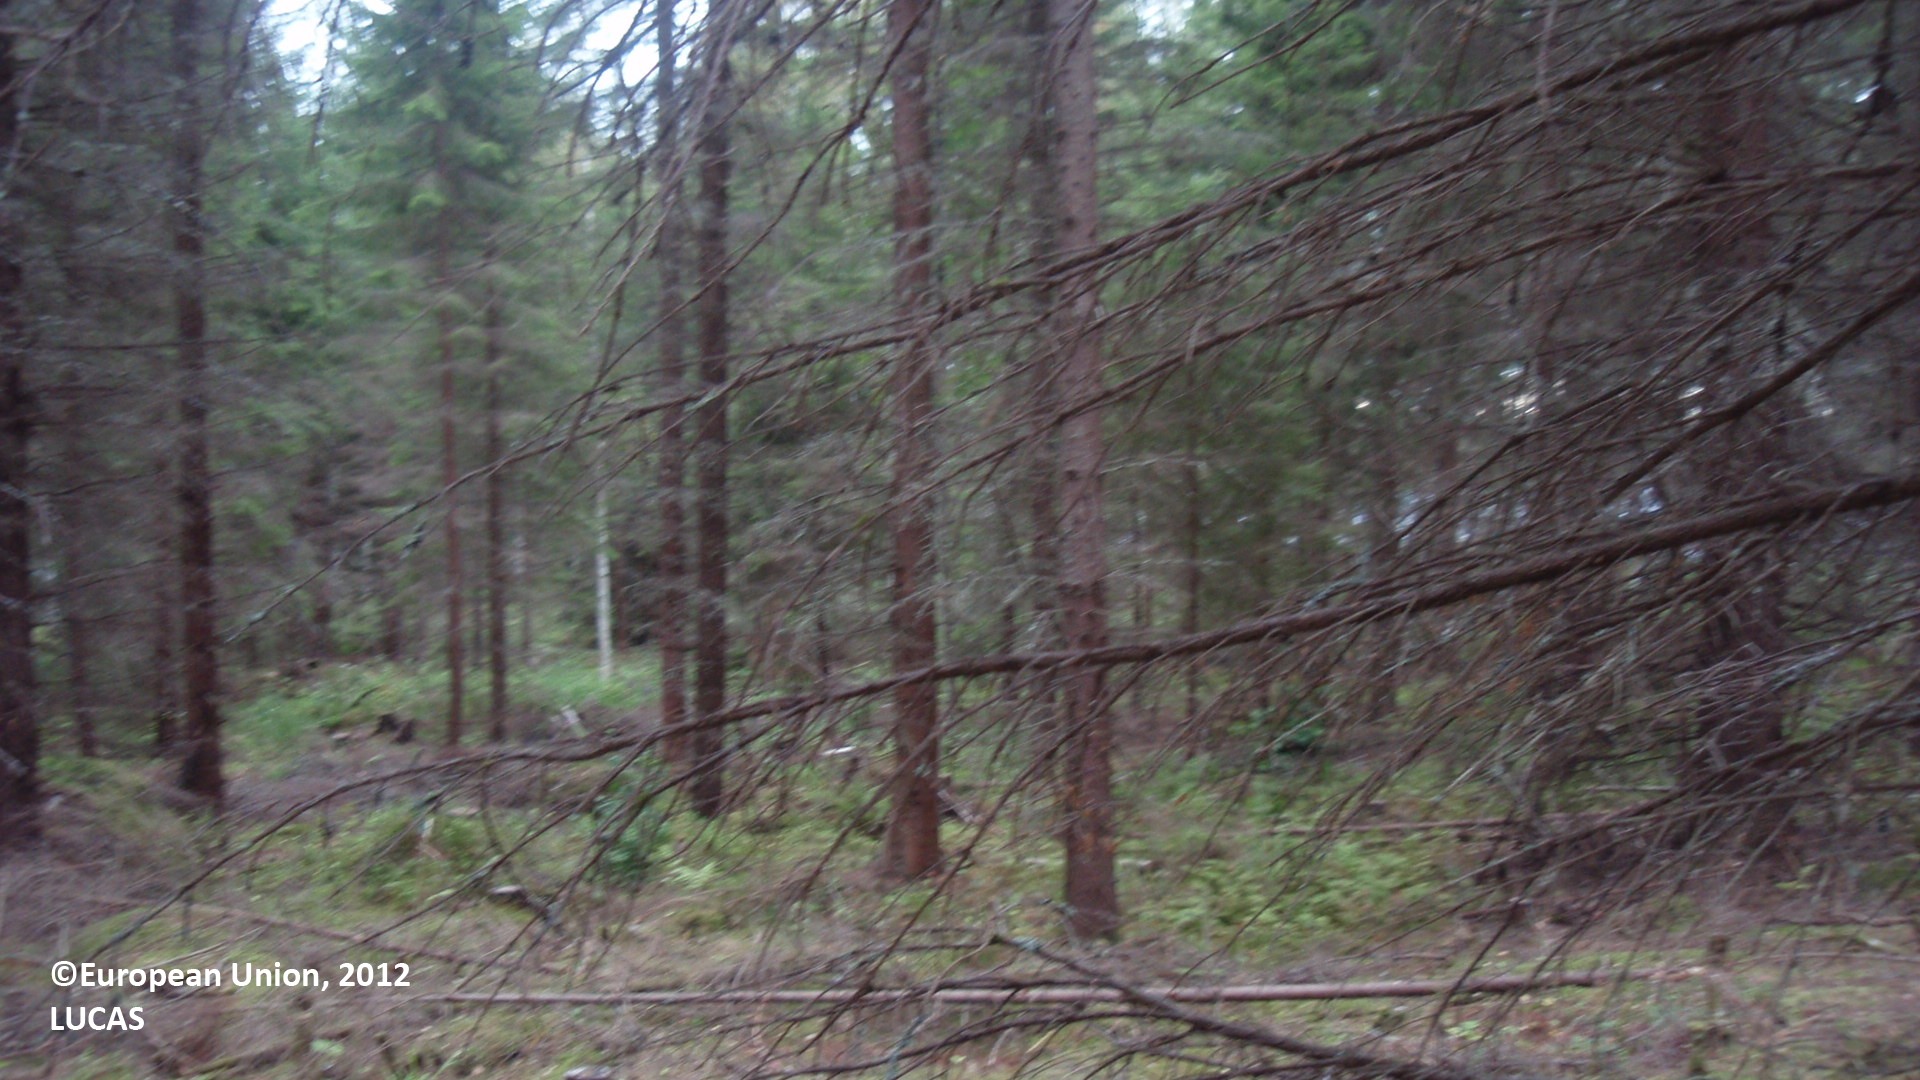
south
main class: Woodland
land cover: Spruce dominated coniferous woodland
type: boreal forest
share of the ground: 50 - 75 %
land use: Forestry
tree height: > 5 m
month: August
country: FI
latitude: 61.1798
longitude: 26.6109
